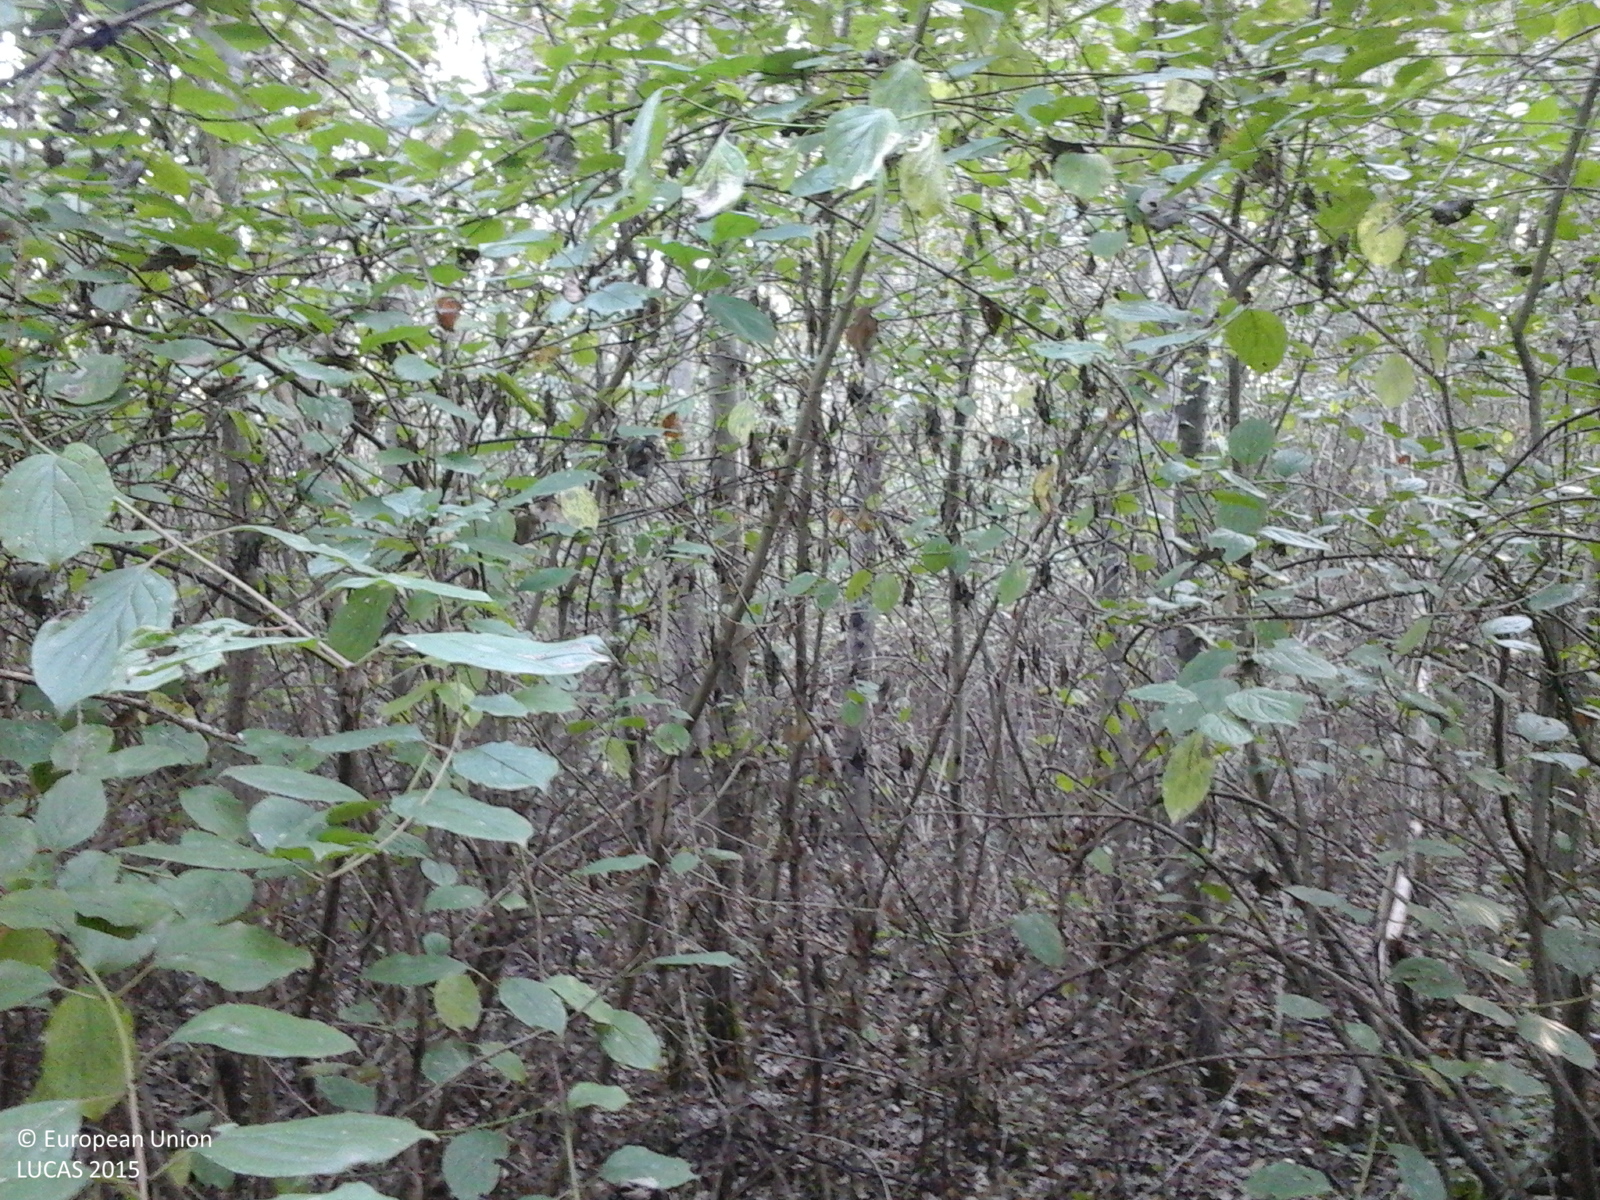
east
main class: Woodland
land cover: Broadleaved woodland
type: non-riverine alder, birch or aspen forest
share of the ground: > 75 %
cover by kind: broadleaved forest trees 100 %
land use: Forestry
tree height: > 5 m
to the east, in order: Broadleaved woodland
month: September
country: RO
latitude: 45.4554
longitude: 22.1500
